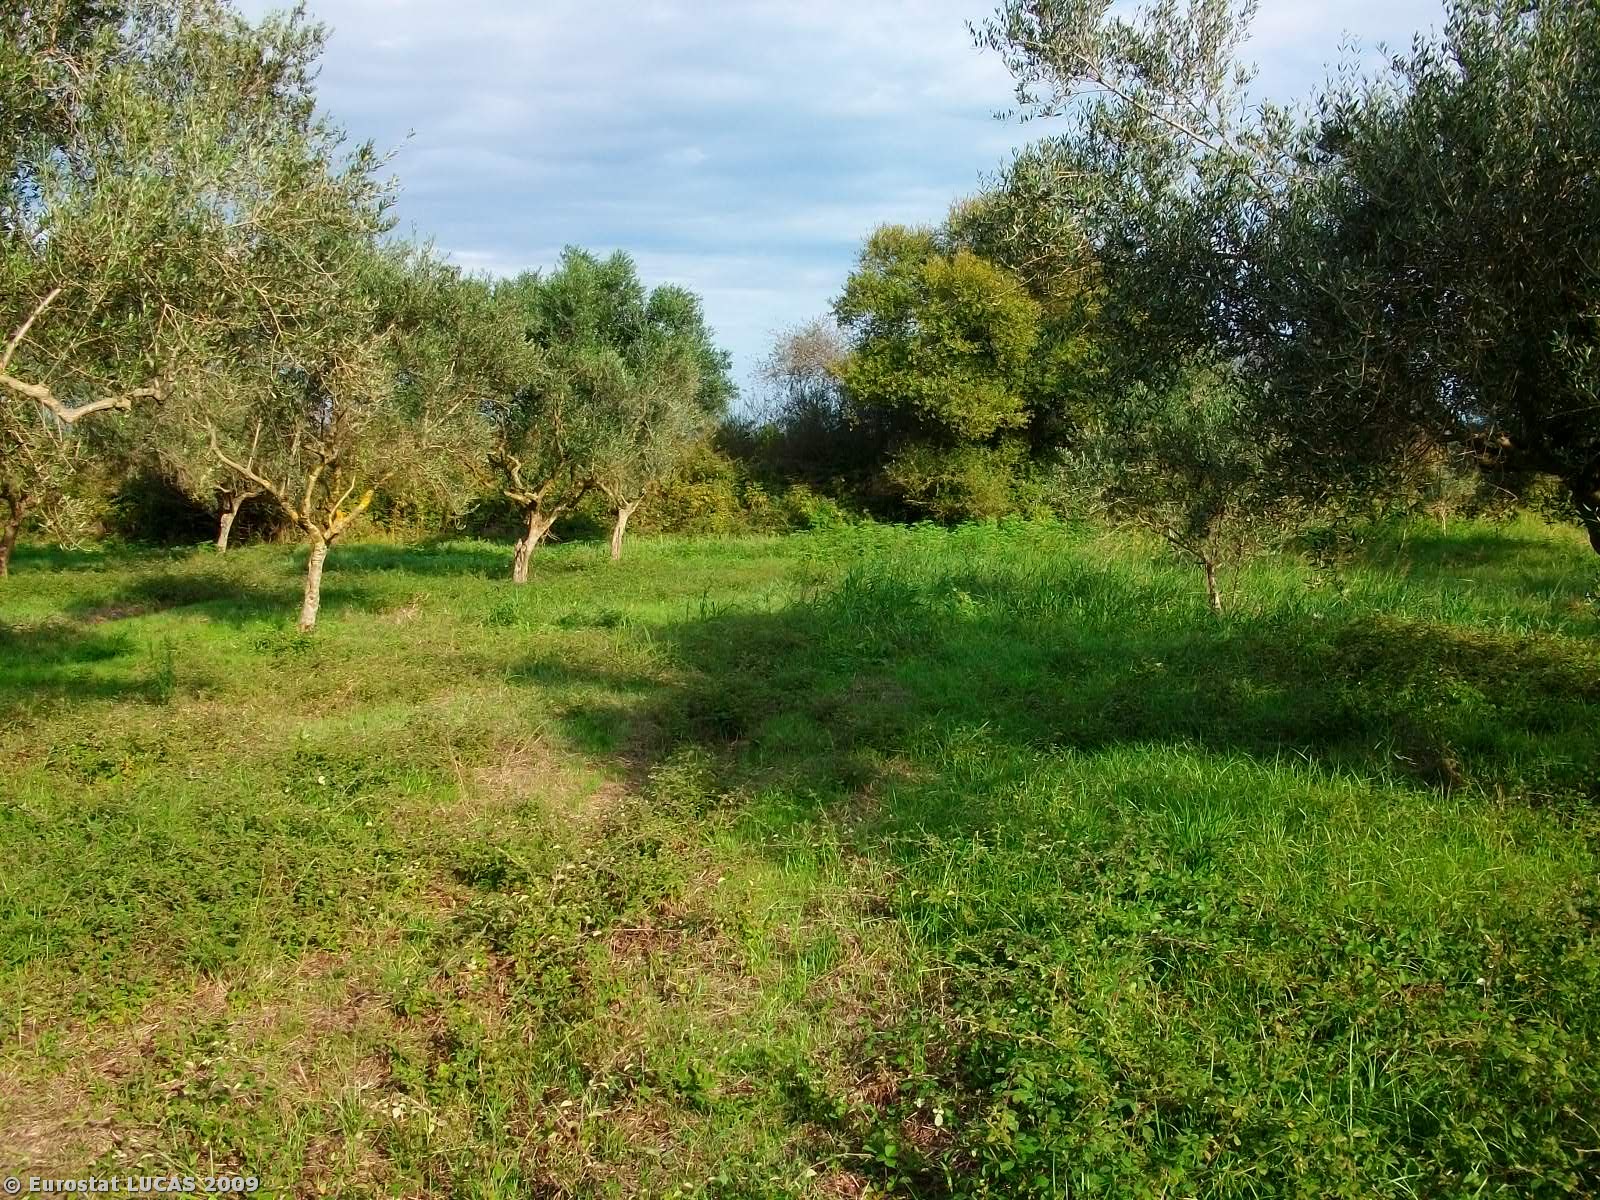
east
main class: Cropland
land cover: Olive groves
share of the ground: 10 - 25 %
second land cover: Grassland with sparse tree/shrub cover
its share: > 75 %
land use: Agriculture (excluding fallow land and kitchen gardens)
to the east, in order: Olive groves; Grassland with sparse tree/shrub cover; Shrubland with sparse tree cover; Paved roads, cycling and walking lanes; Electric lines; Shruby margins; Grassland without tree/shrub cover; Fences; Single bushes/trees; Grassland with sparse tree/shrub cover; Artificial constructions in urban areas; Single bushes/trees; Grassland with sparse tree/shrub cover; Fences; Ditches and canals; Tracks; Maize
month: September
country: GR
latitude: 37.6898
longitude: 21.3327
